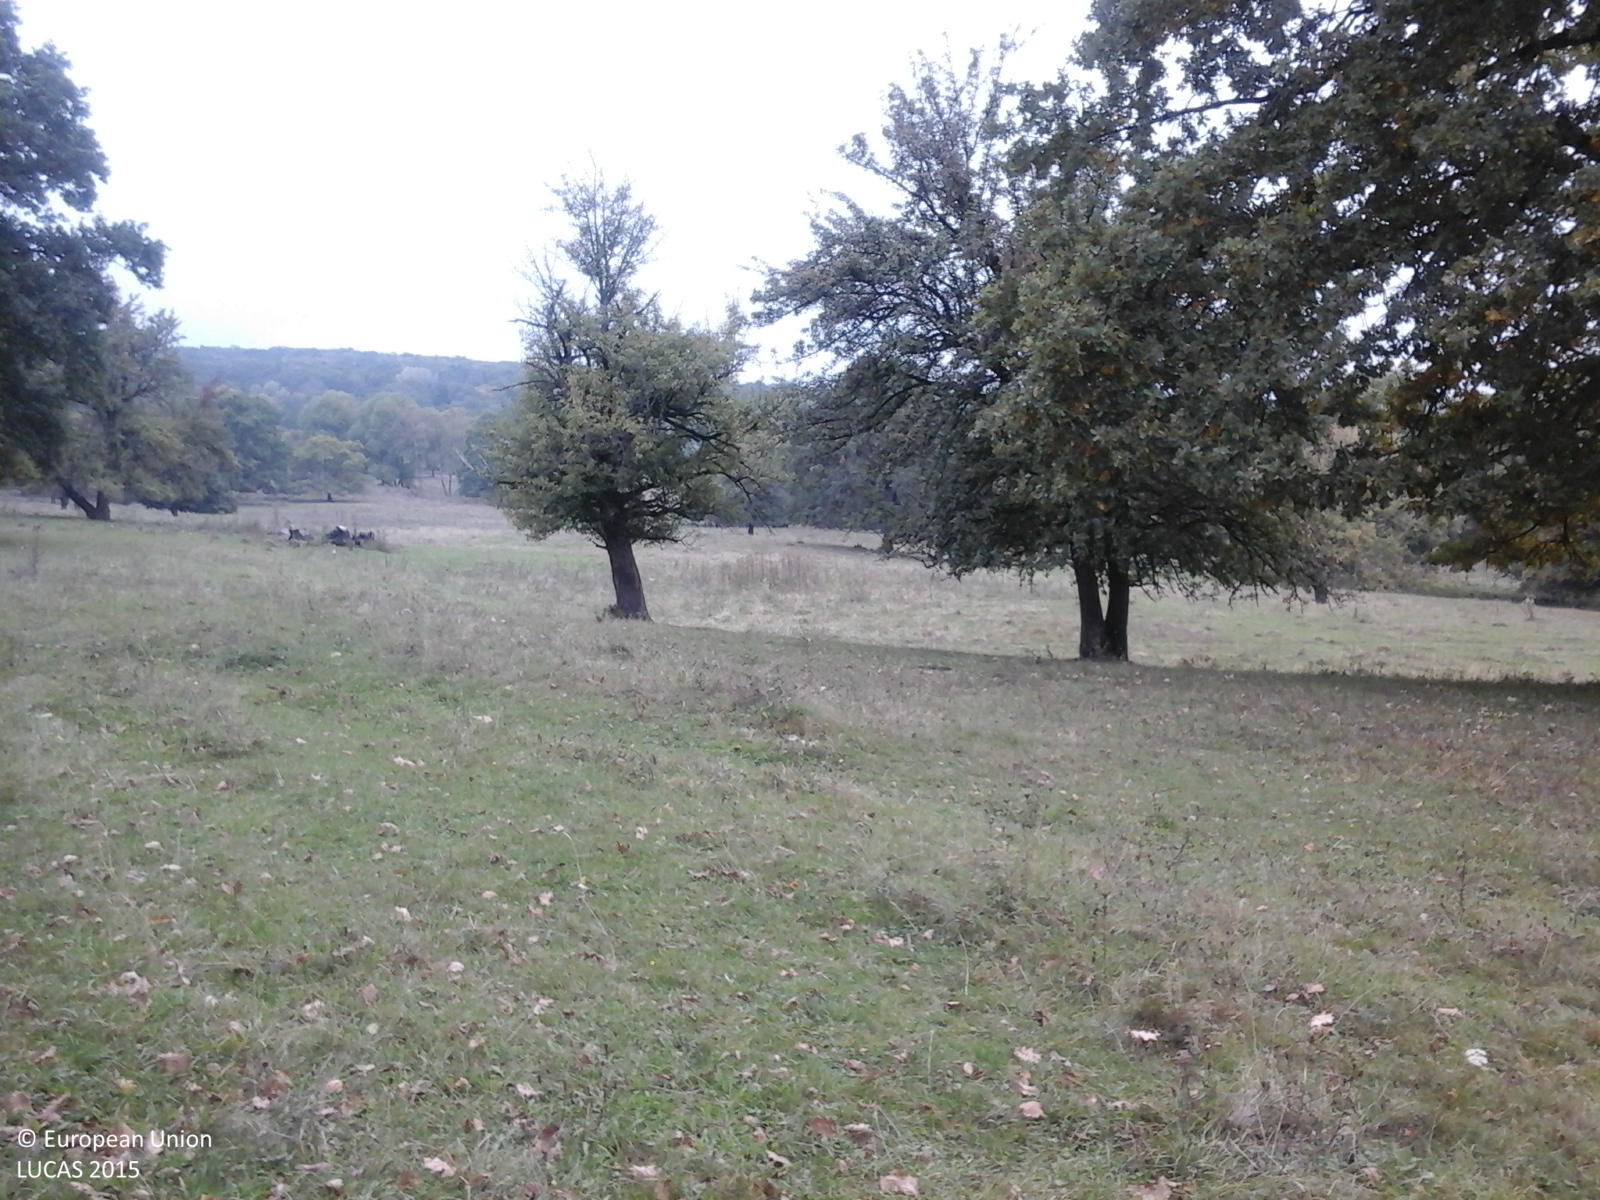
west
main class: Grassland
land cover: Grassland with sparse tree/shrub cover
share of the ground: > 75 %
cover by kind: herbaceous plants 95 %, broadleaved forest trees 5 %
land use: Agriculture (excluding fallow land and kitchen gardens)
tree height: > 5 m
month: October
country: RO
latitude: 46.0049
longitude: 25.2204
